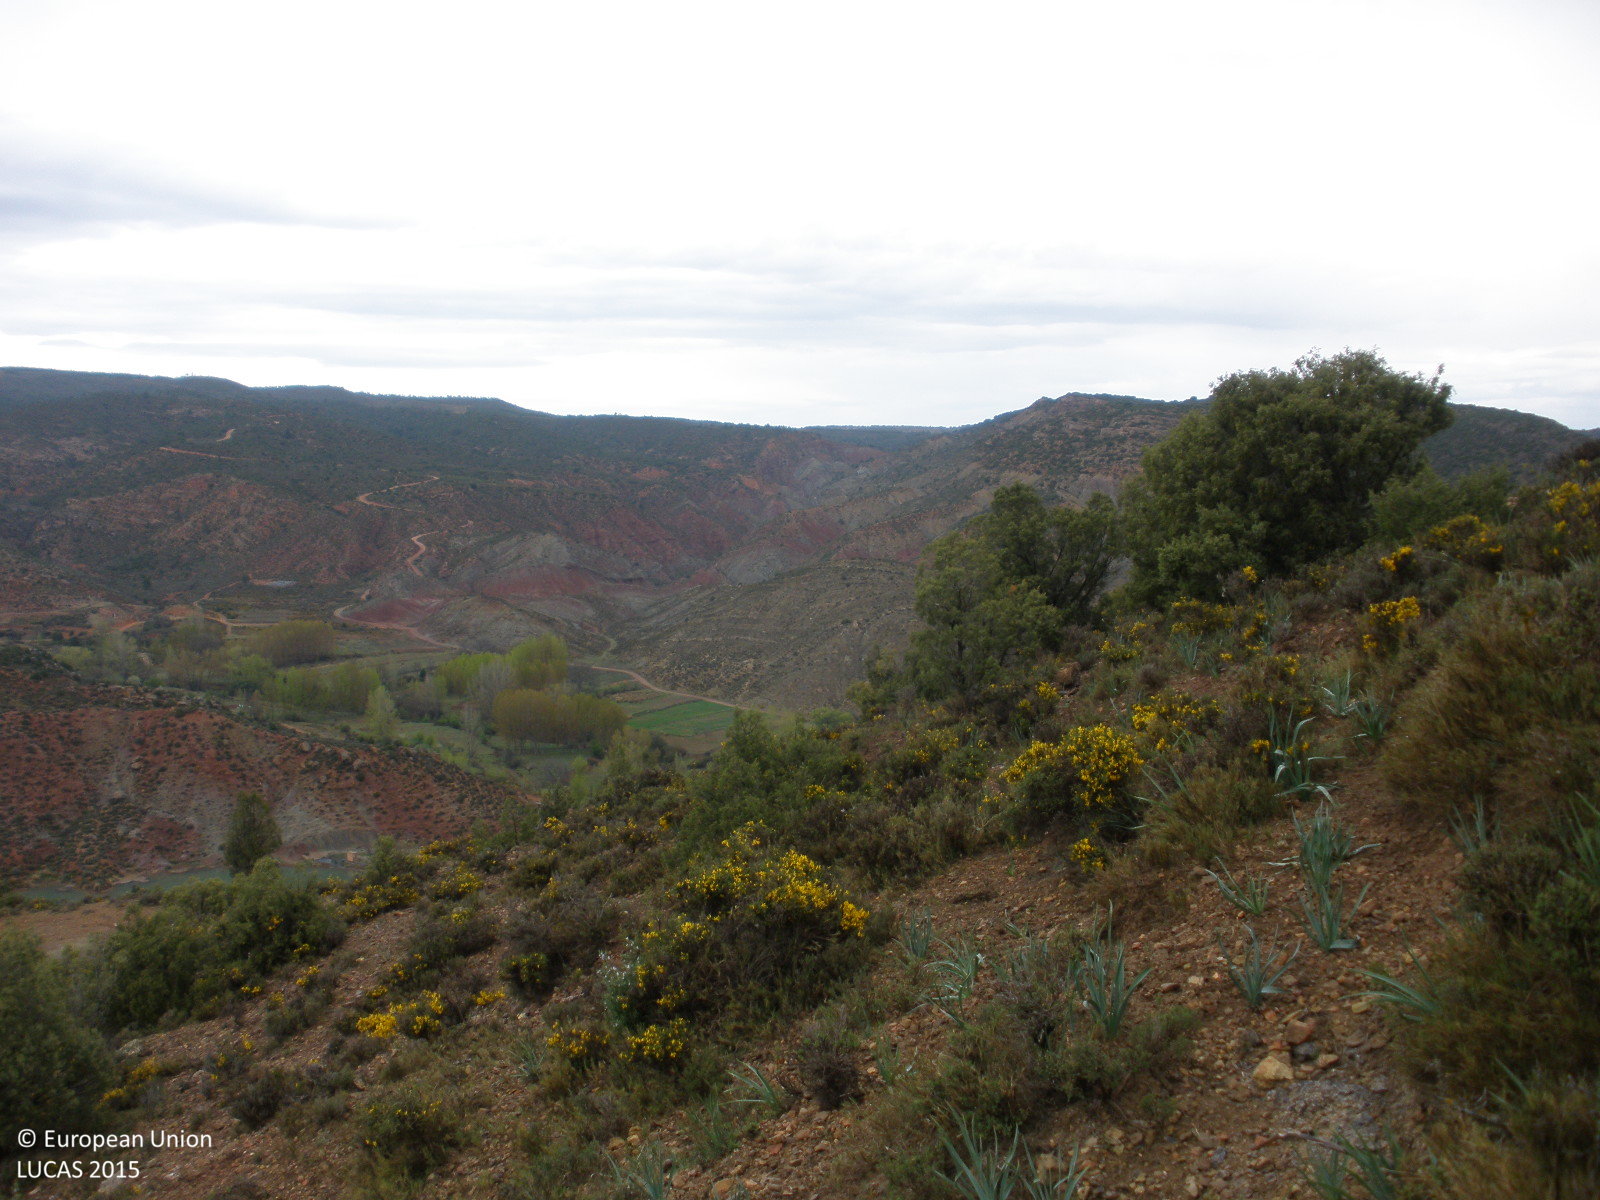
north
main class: Shrubland
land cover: Shrubland without tree cover
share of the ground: 50 - 75 %
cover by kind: shrubs 60 %, consolidated bare surface 30 %, herbaceous plants 10 %
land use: Agriculture (excluding fallow land and kitchen gardens)
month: April
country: ES
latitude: 40.2429
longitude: -1.2128
